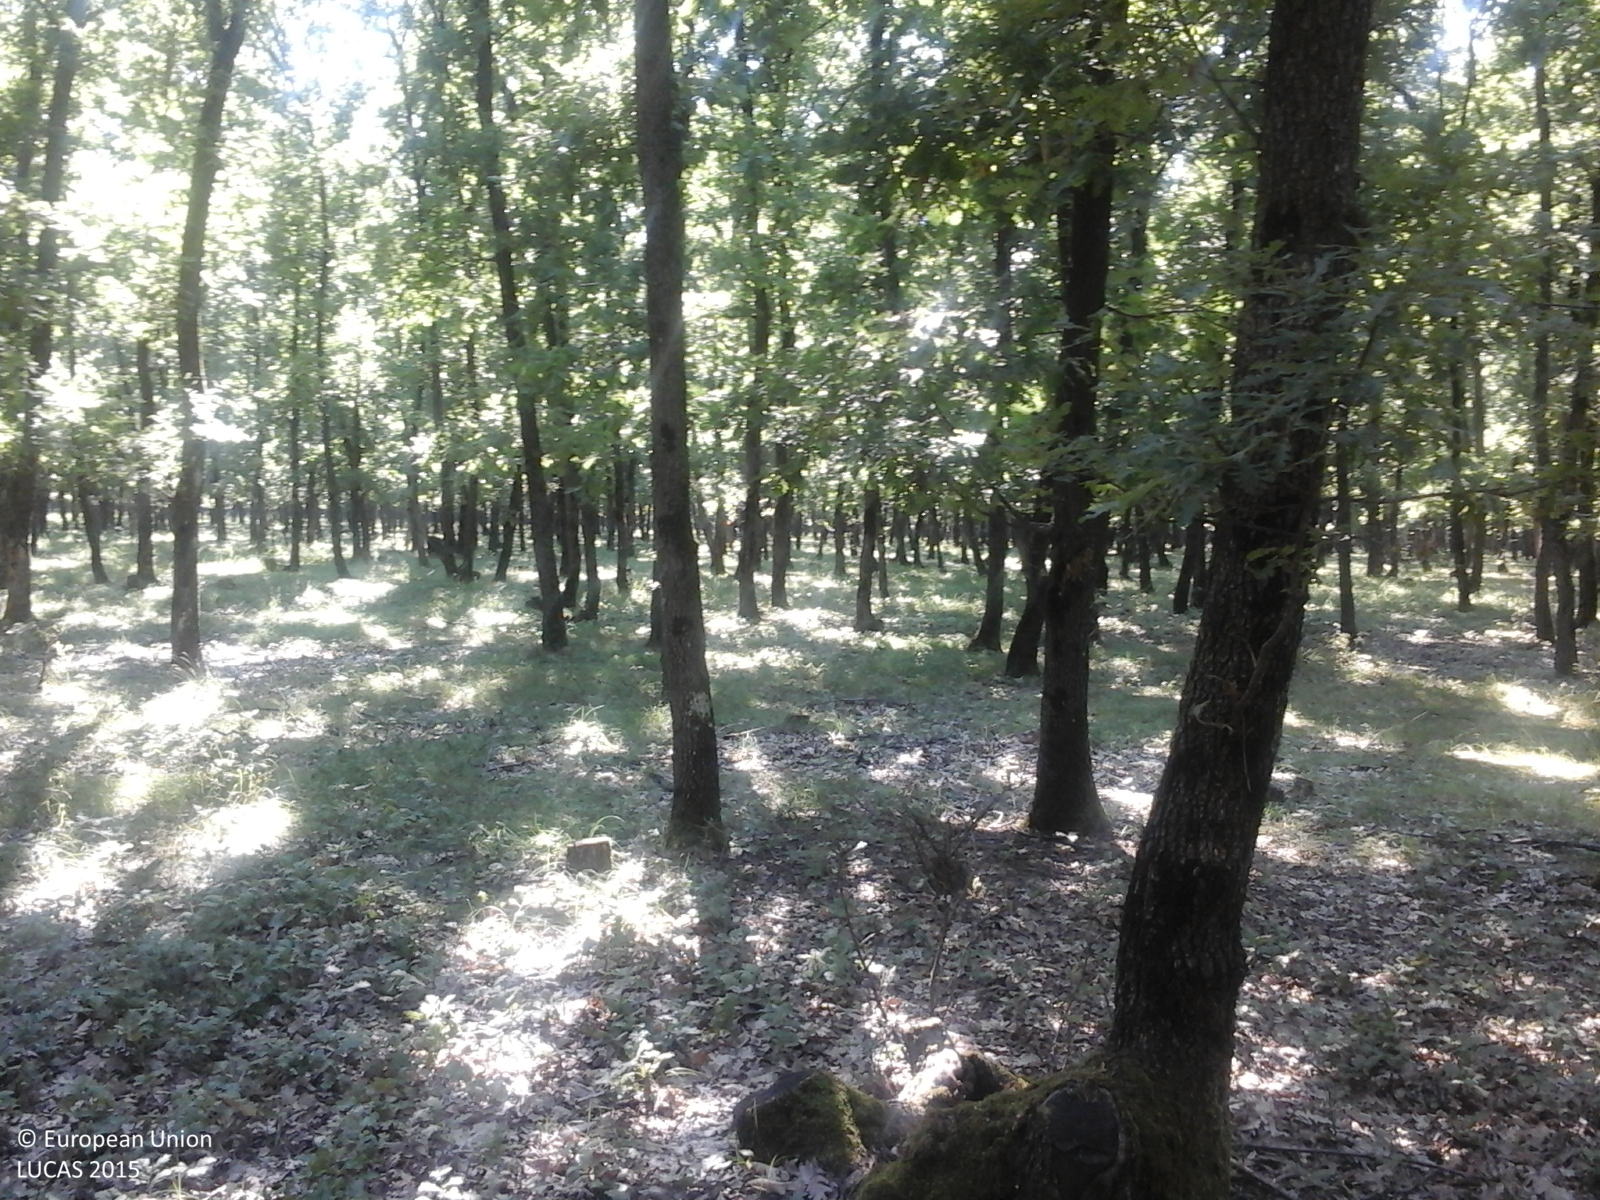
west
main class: Woodland
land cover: Broadleaved woodland
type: thermophilous deciduous forest
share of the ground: > 75 %
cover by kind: broadleaved forest trees 95 %, herbaceous plants 5 %
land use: Forestry
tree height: > 5 m
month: July
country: RO
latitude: 44.5820
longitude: 24.4155
